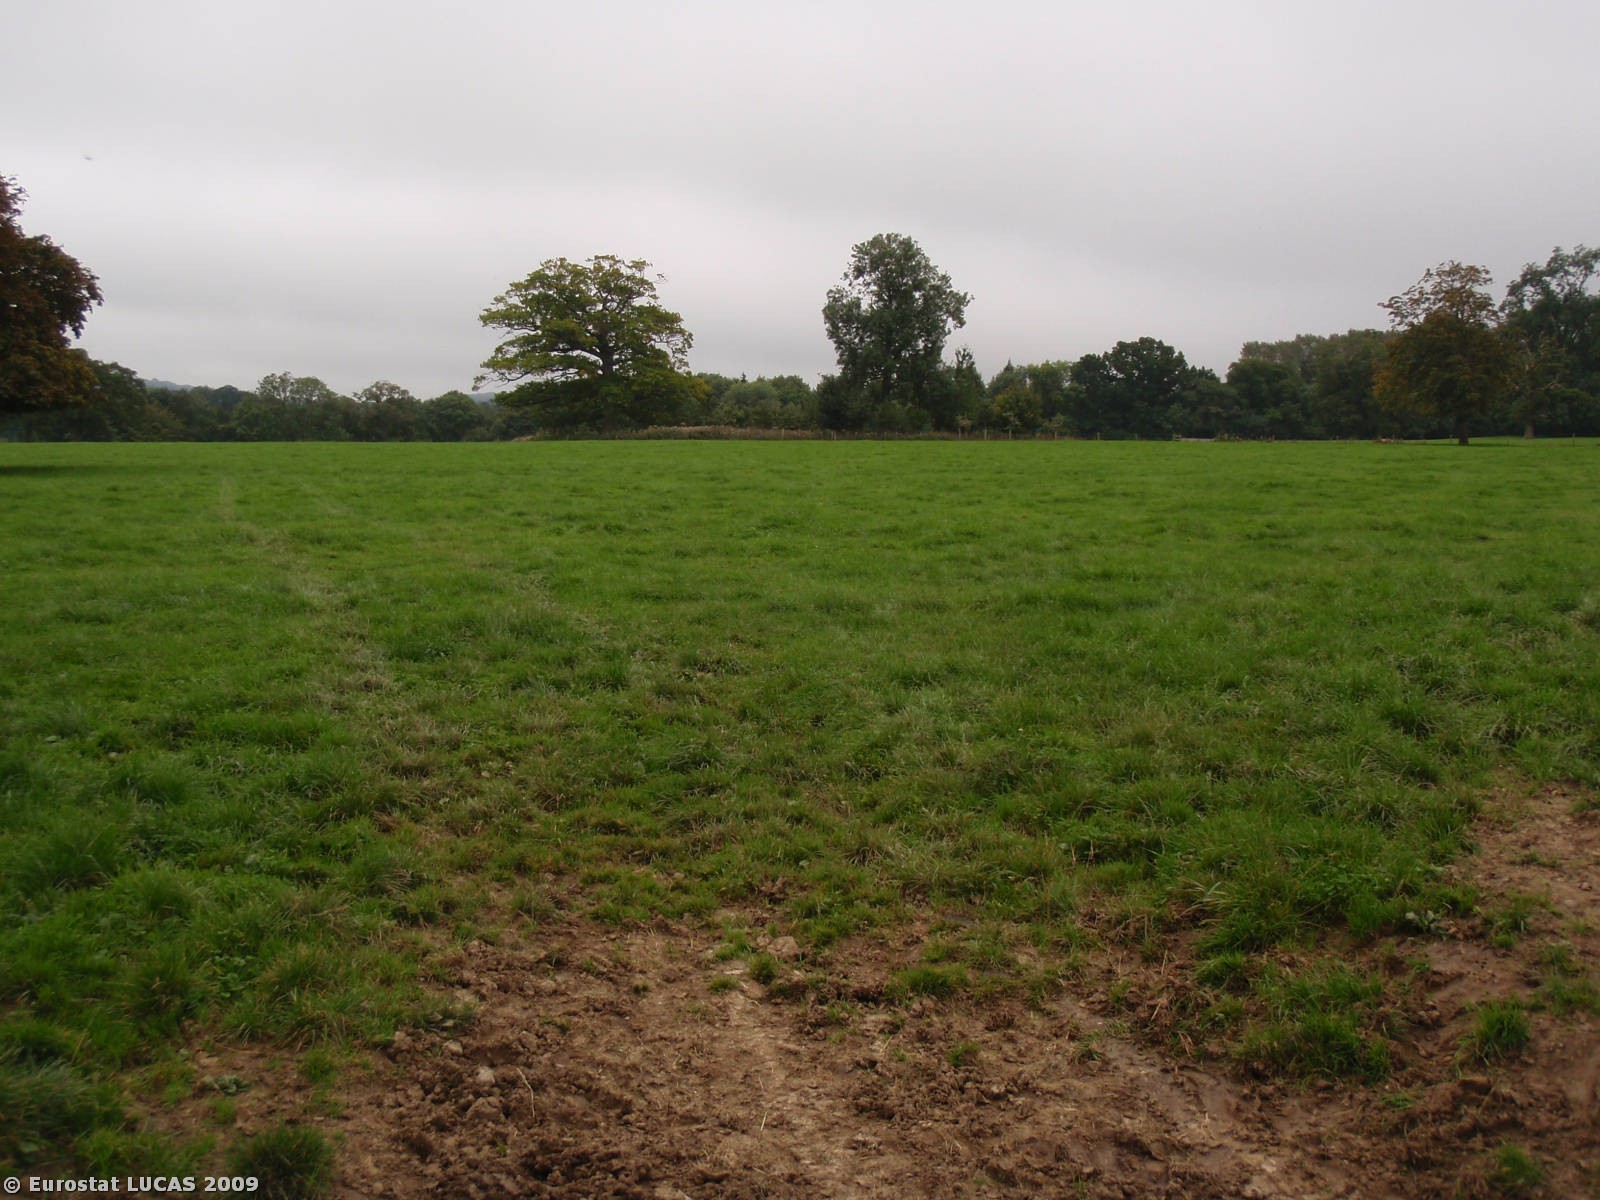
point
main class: Grassland
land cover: Grassland without tree/shrub cover
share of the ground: > 75 %
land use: Agriculture (excluding fallow land and kitchen gardens)
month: September
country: GB
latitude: 50.8638
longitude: -2.6138
